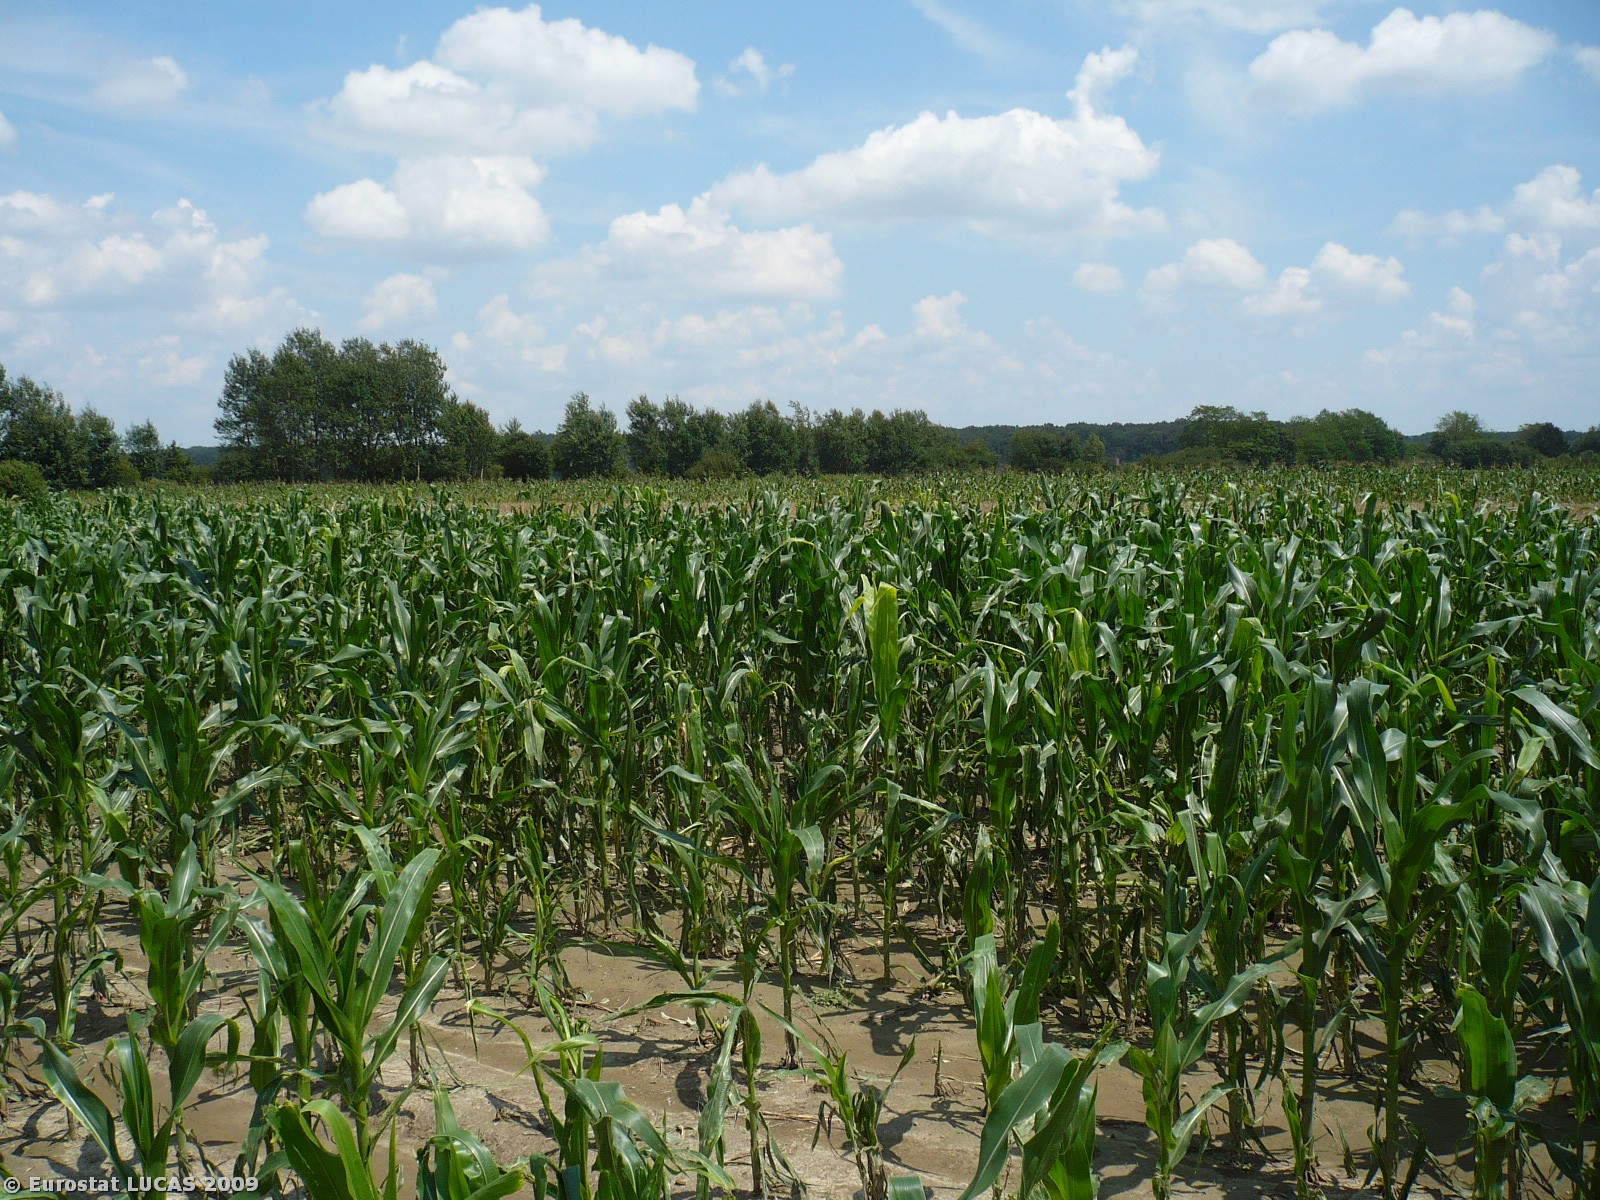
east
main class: Cropland
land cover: Maize
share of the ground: 50 - 75 %
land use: Agriculture (excluding fallow land and kitchen gardens)
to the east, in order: Maize; Grass margins; Common wheat; Grass margins; Maize; Grass margins; Barley; Grass margins; Common wheat; Abandoned hedges; Rivers and streams; Abandoned hedges; Maize
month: July
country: SI
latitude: 46.6494
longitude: 16.3643
